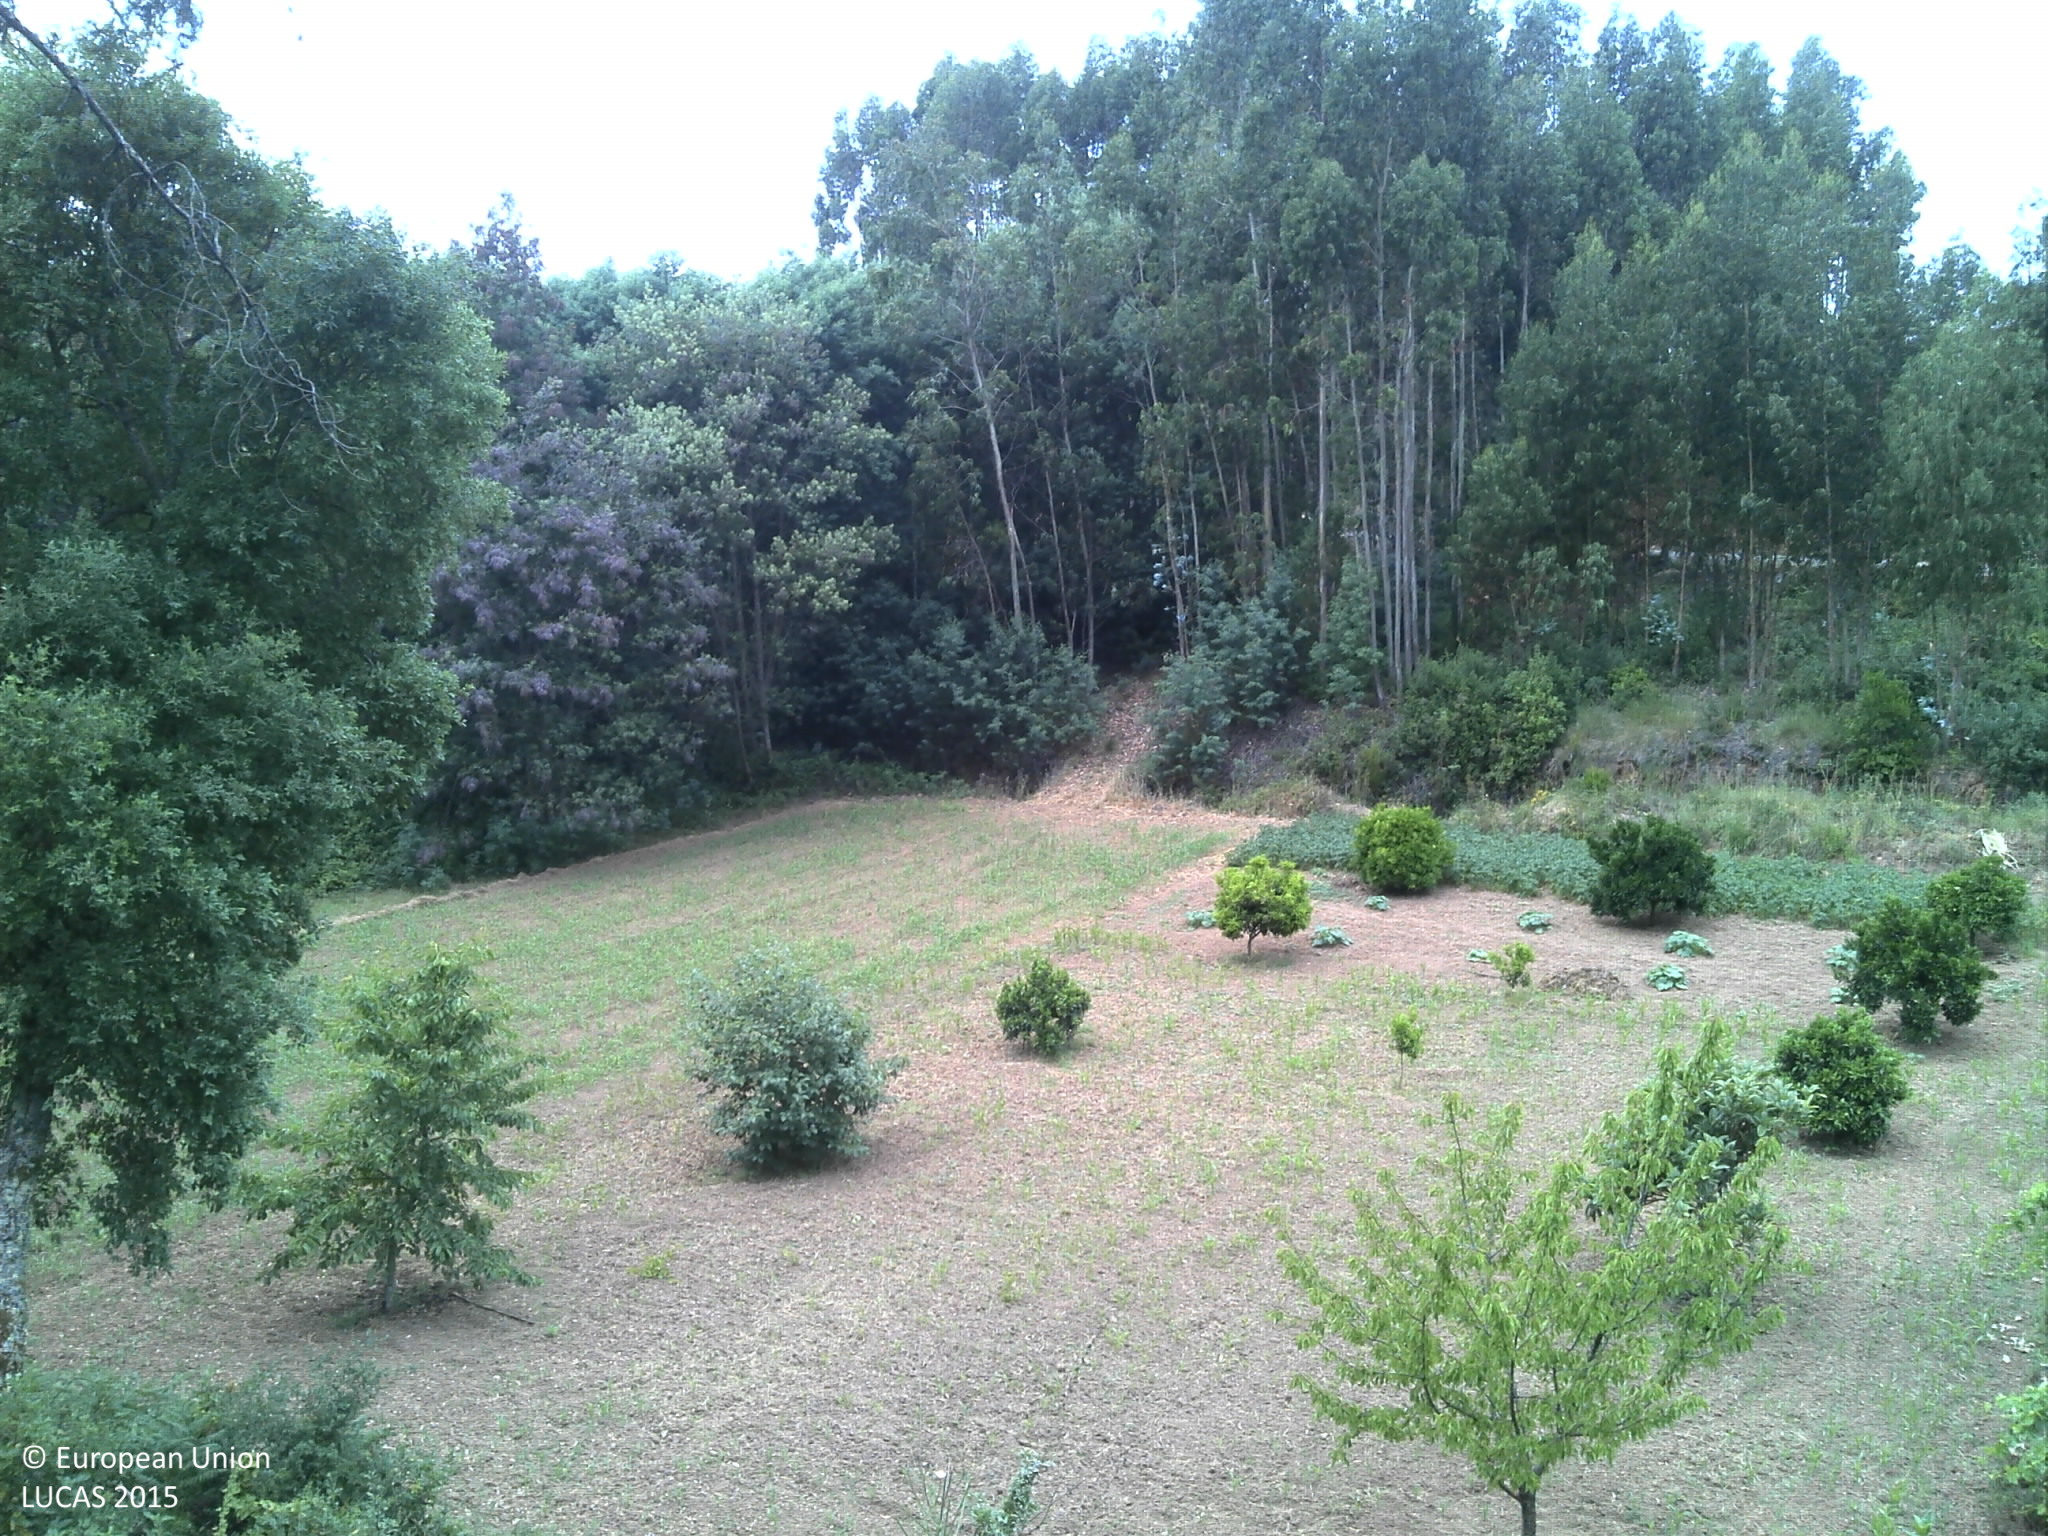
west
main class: Shrubland
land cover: Shrubland without tree cover
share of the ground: > 75 %
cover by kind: shrubs 80 %, unconsolidated bare surface 15 %, herbaceous plants 5 %
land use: Semi-natural and natural areas not in use
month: June
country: PT
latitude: 40.3165
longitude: -8.3346
